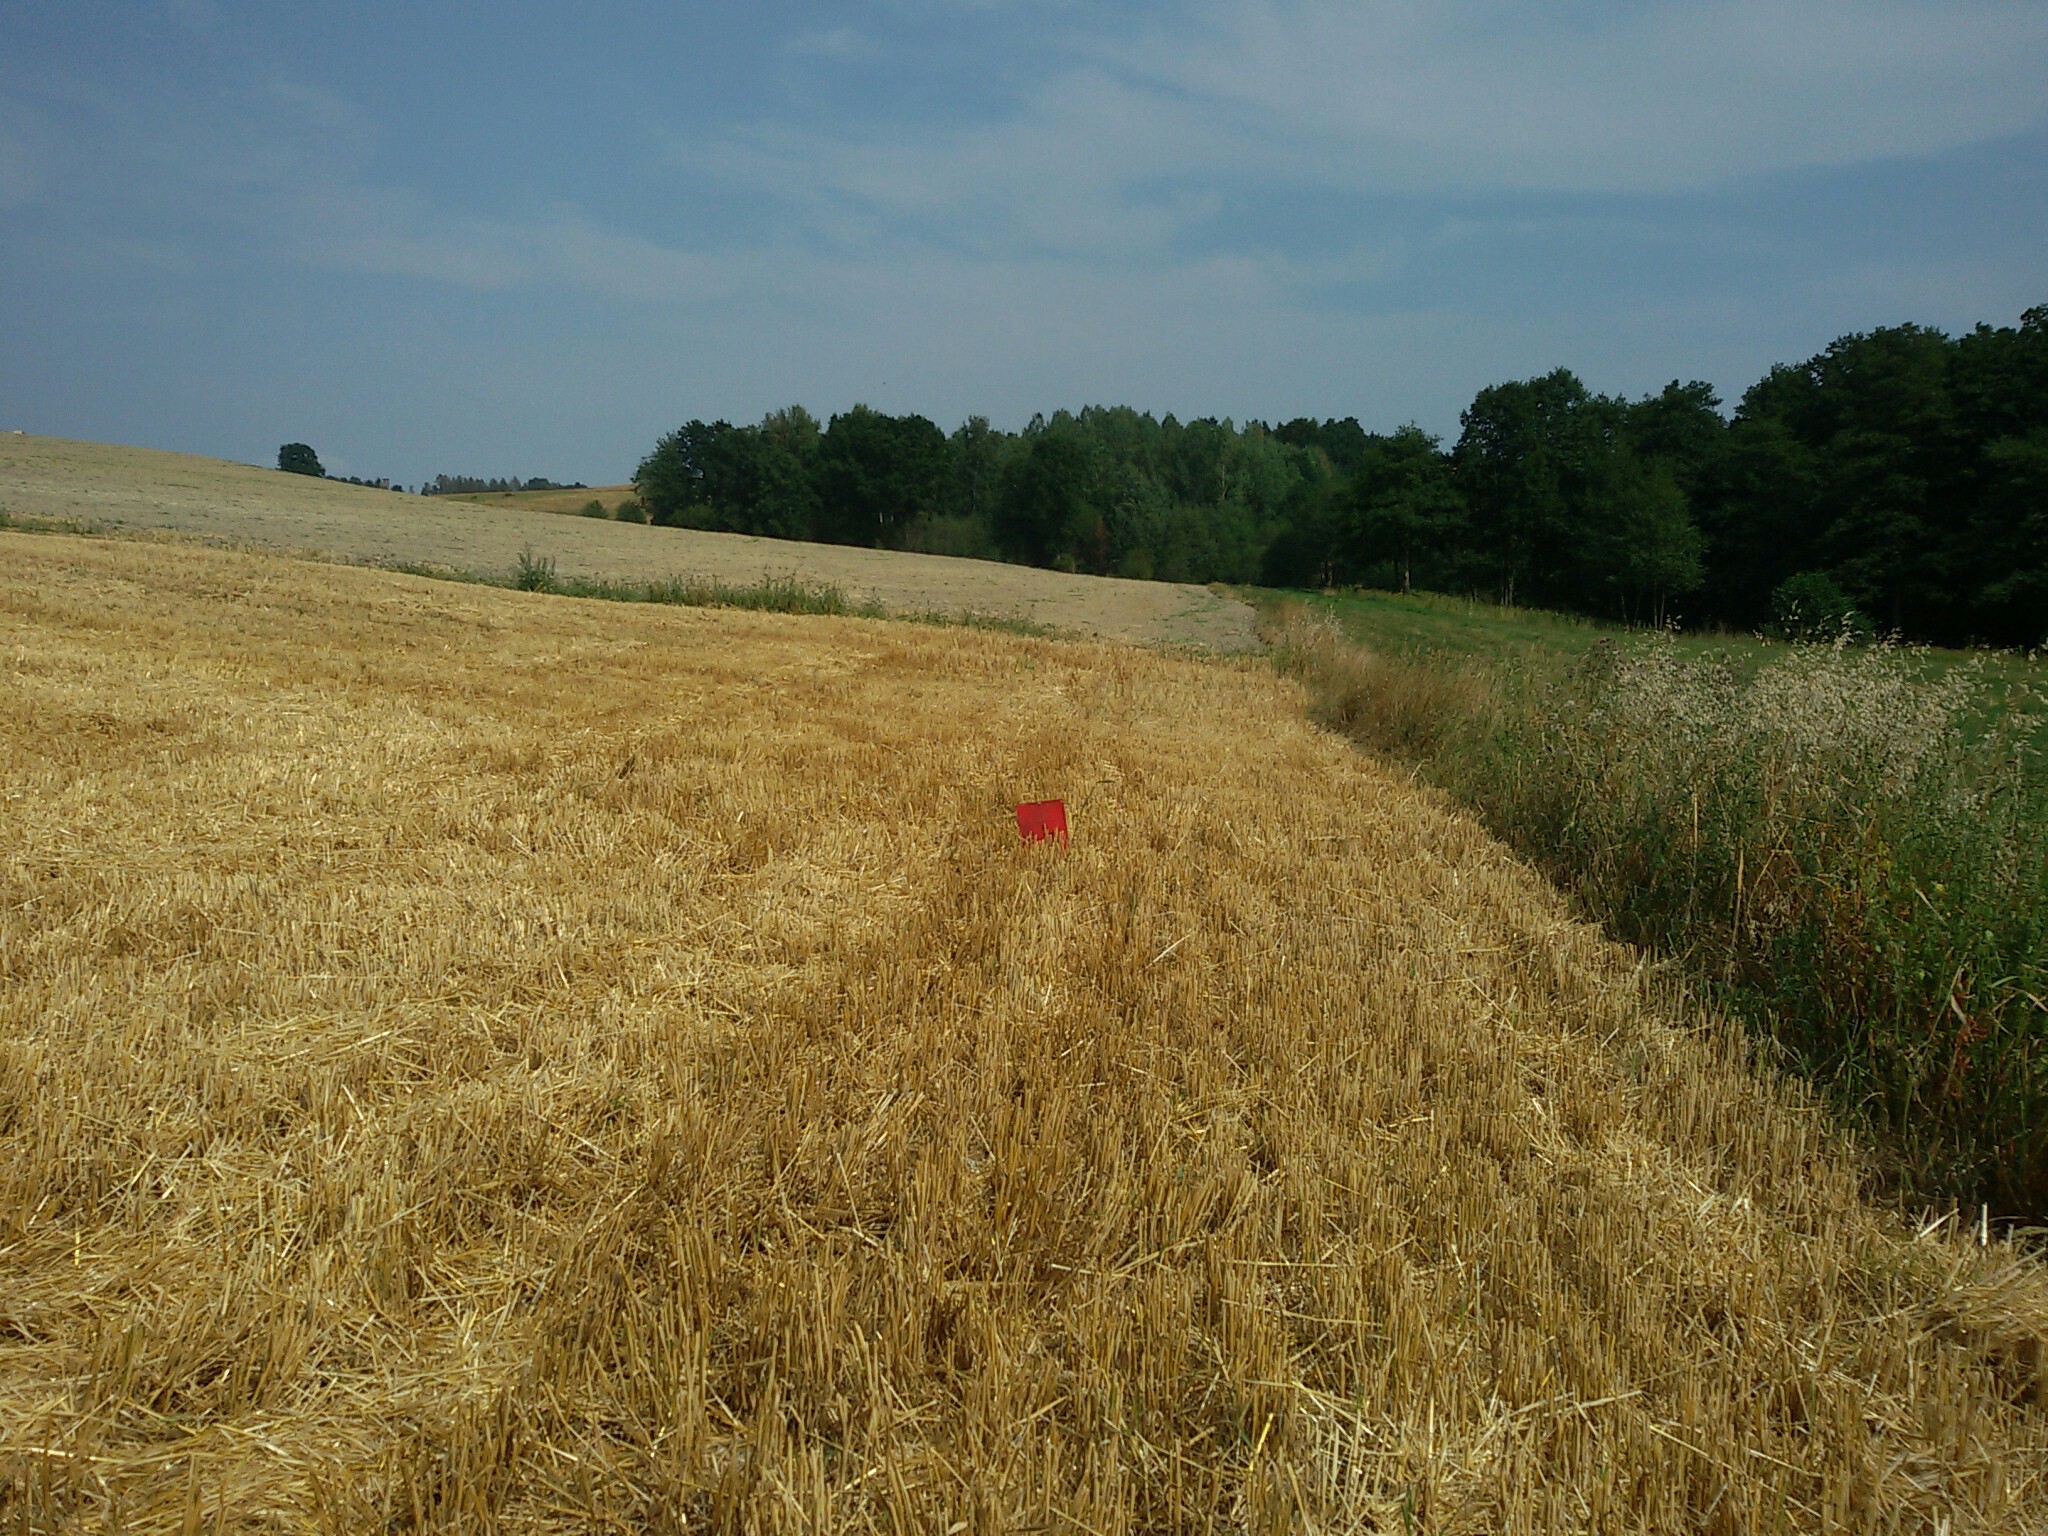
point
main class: Cropland
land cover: Barley
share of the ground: > 75 %
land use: Agriculture (excluding fallow land and kitchen gardens)
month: August
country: PL
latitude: 50.9617
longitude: 15.6858
